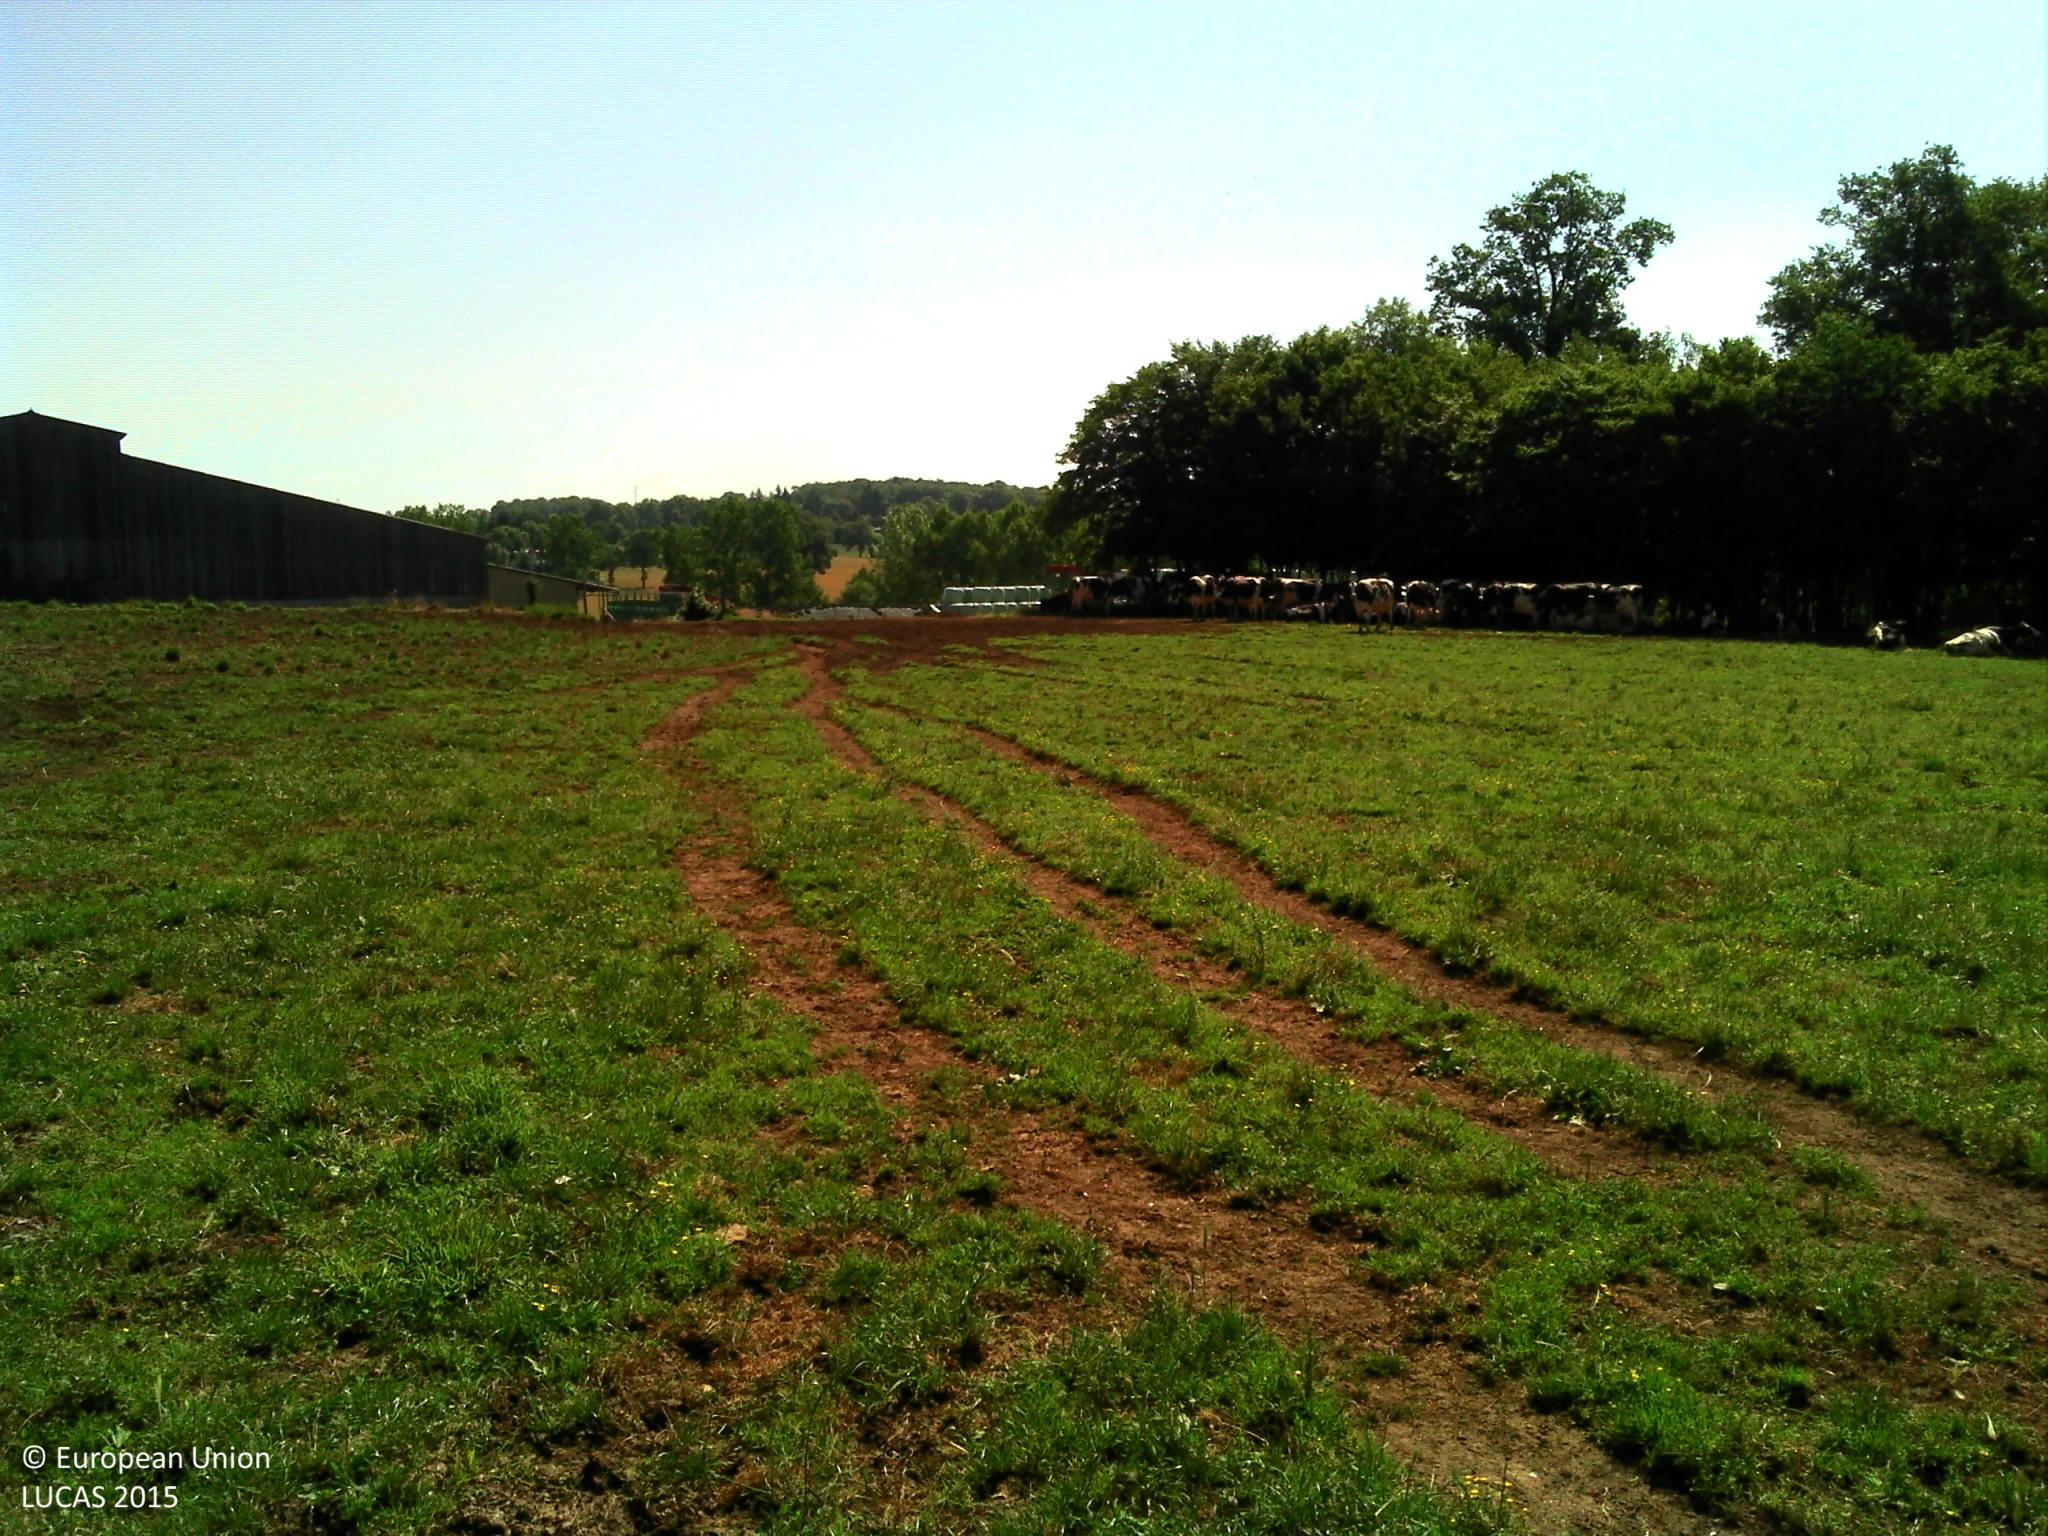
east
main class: Grassland
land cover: Grassland without tree/shrub cover
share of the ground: > 75 %
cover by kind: herbaceous plants 100 %
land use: Agriculture (excluding fallow land and kitchen gardens)
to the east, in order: Grassland without tree/shrub cover; Fences; Tracks; Broadleaved woodland; Artificial constructions in urban areas; Fences; Grassland without tree/shrub cover; Electric lines; Grassland without tree/shrub cover
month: June
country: FR
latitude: 45.8814
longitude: 0.5928
